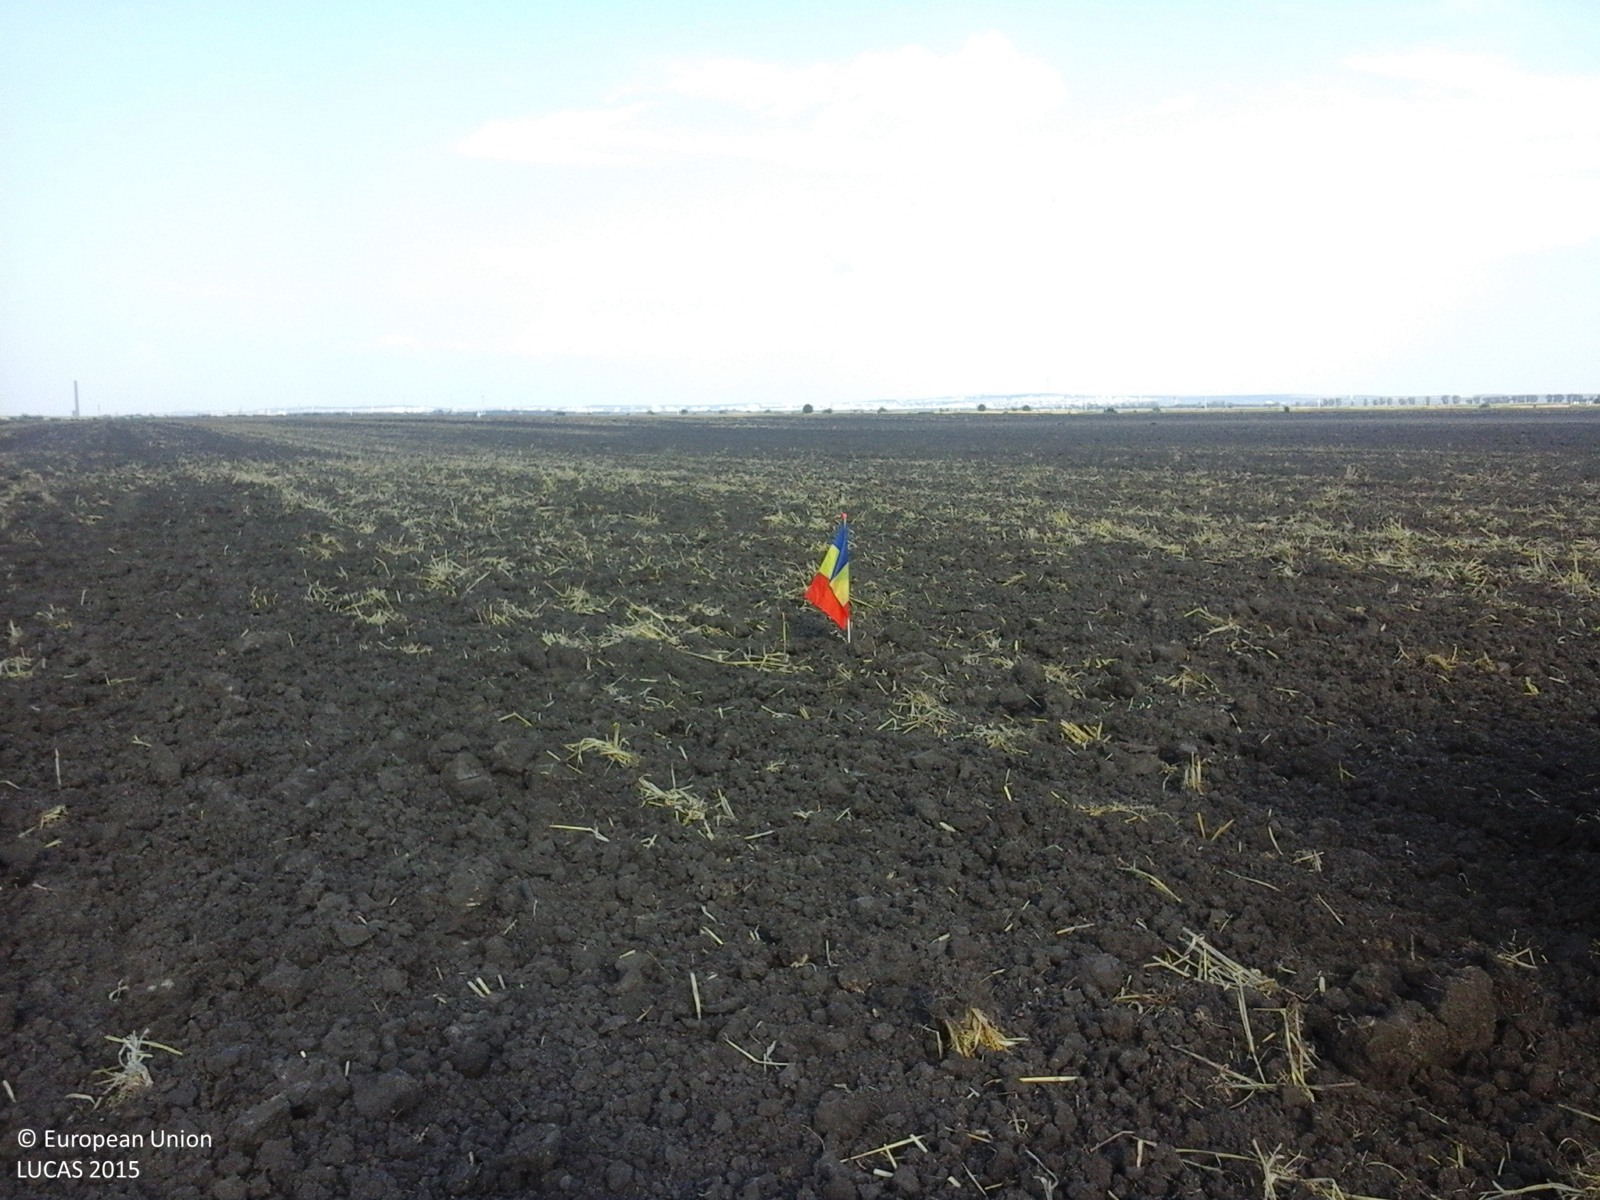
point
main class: Cropland
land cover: Common wheat
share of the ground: < 10 %
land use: Agriculture (excluding fallow land and kitchen gardens)
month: July
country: RO
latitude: 43.8777
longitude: 25.8364
